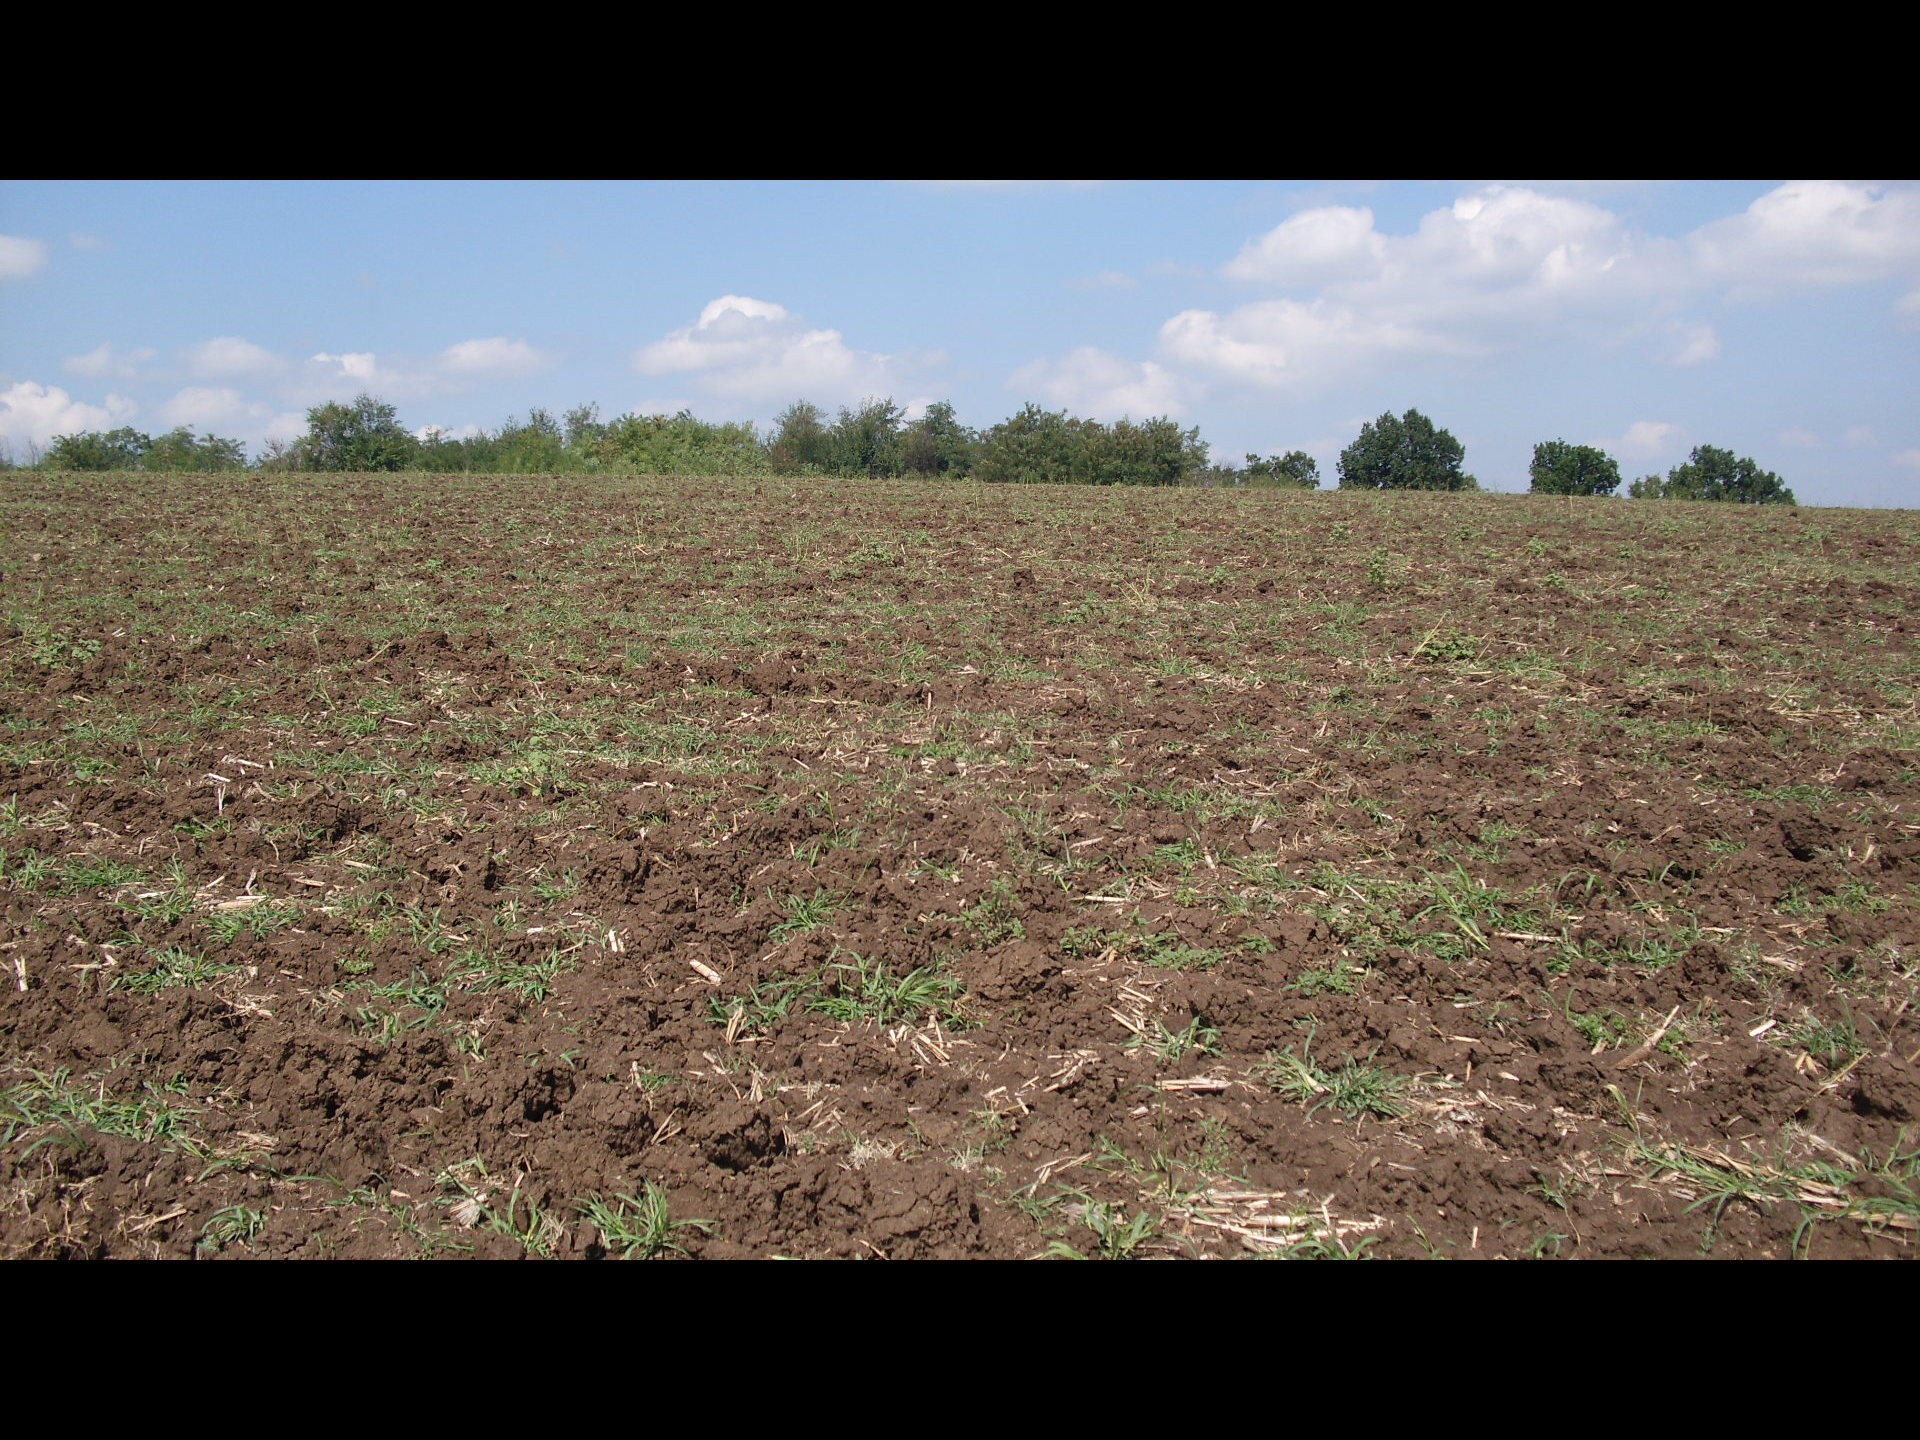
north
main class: Cropland
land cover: Maize
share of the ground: < 10 %
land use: Agriculture (excluding fallow land and kitchen gardens)
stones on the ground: < 10 %
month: August
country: BG
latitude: 43.6748
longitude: 23.0002
